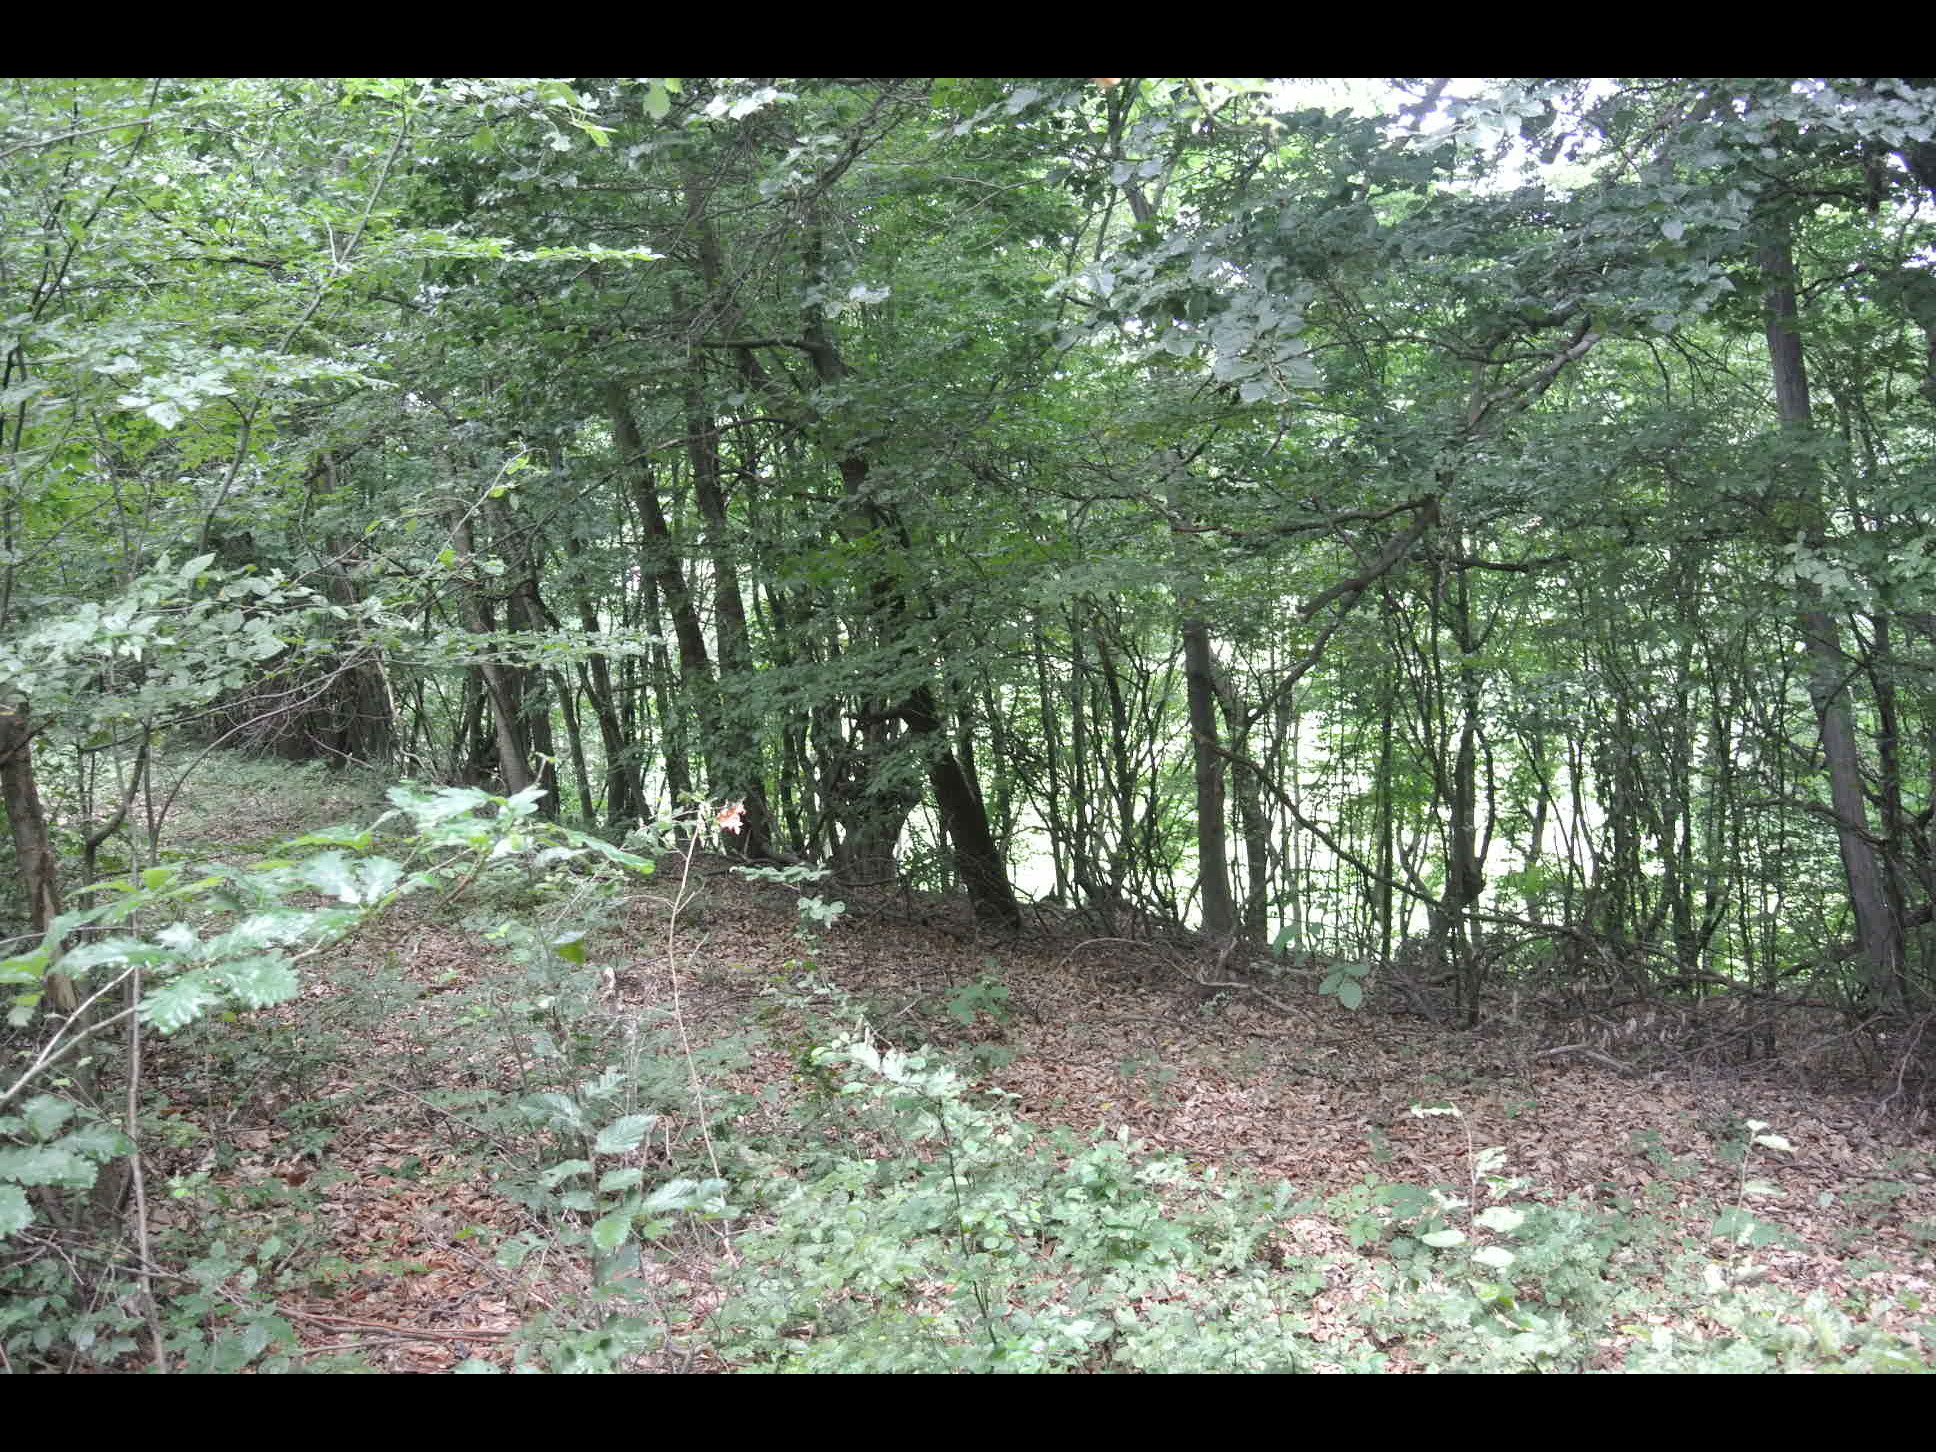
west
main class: Woodland
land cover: Broadleaved woodland
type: beech forest
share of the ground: > 75 %
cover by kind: broadleaved forest trees 100 %
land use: Forestry
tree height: > 5 m
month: July
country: AT
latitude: 47.6221
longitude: 16.4040
